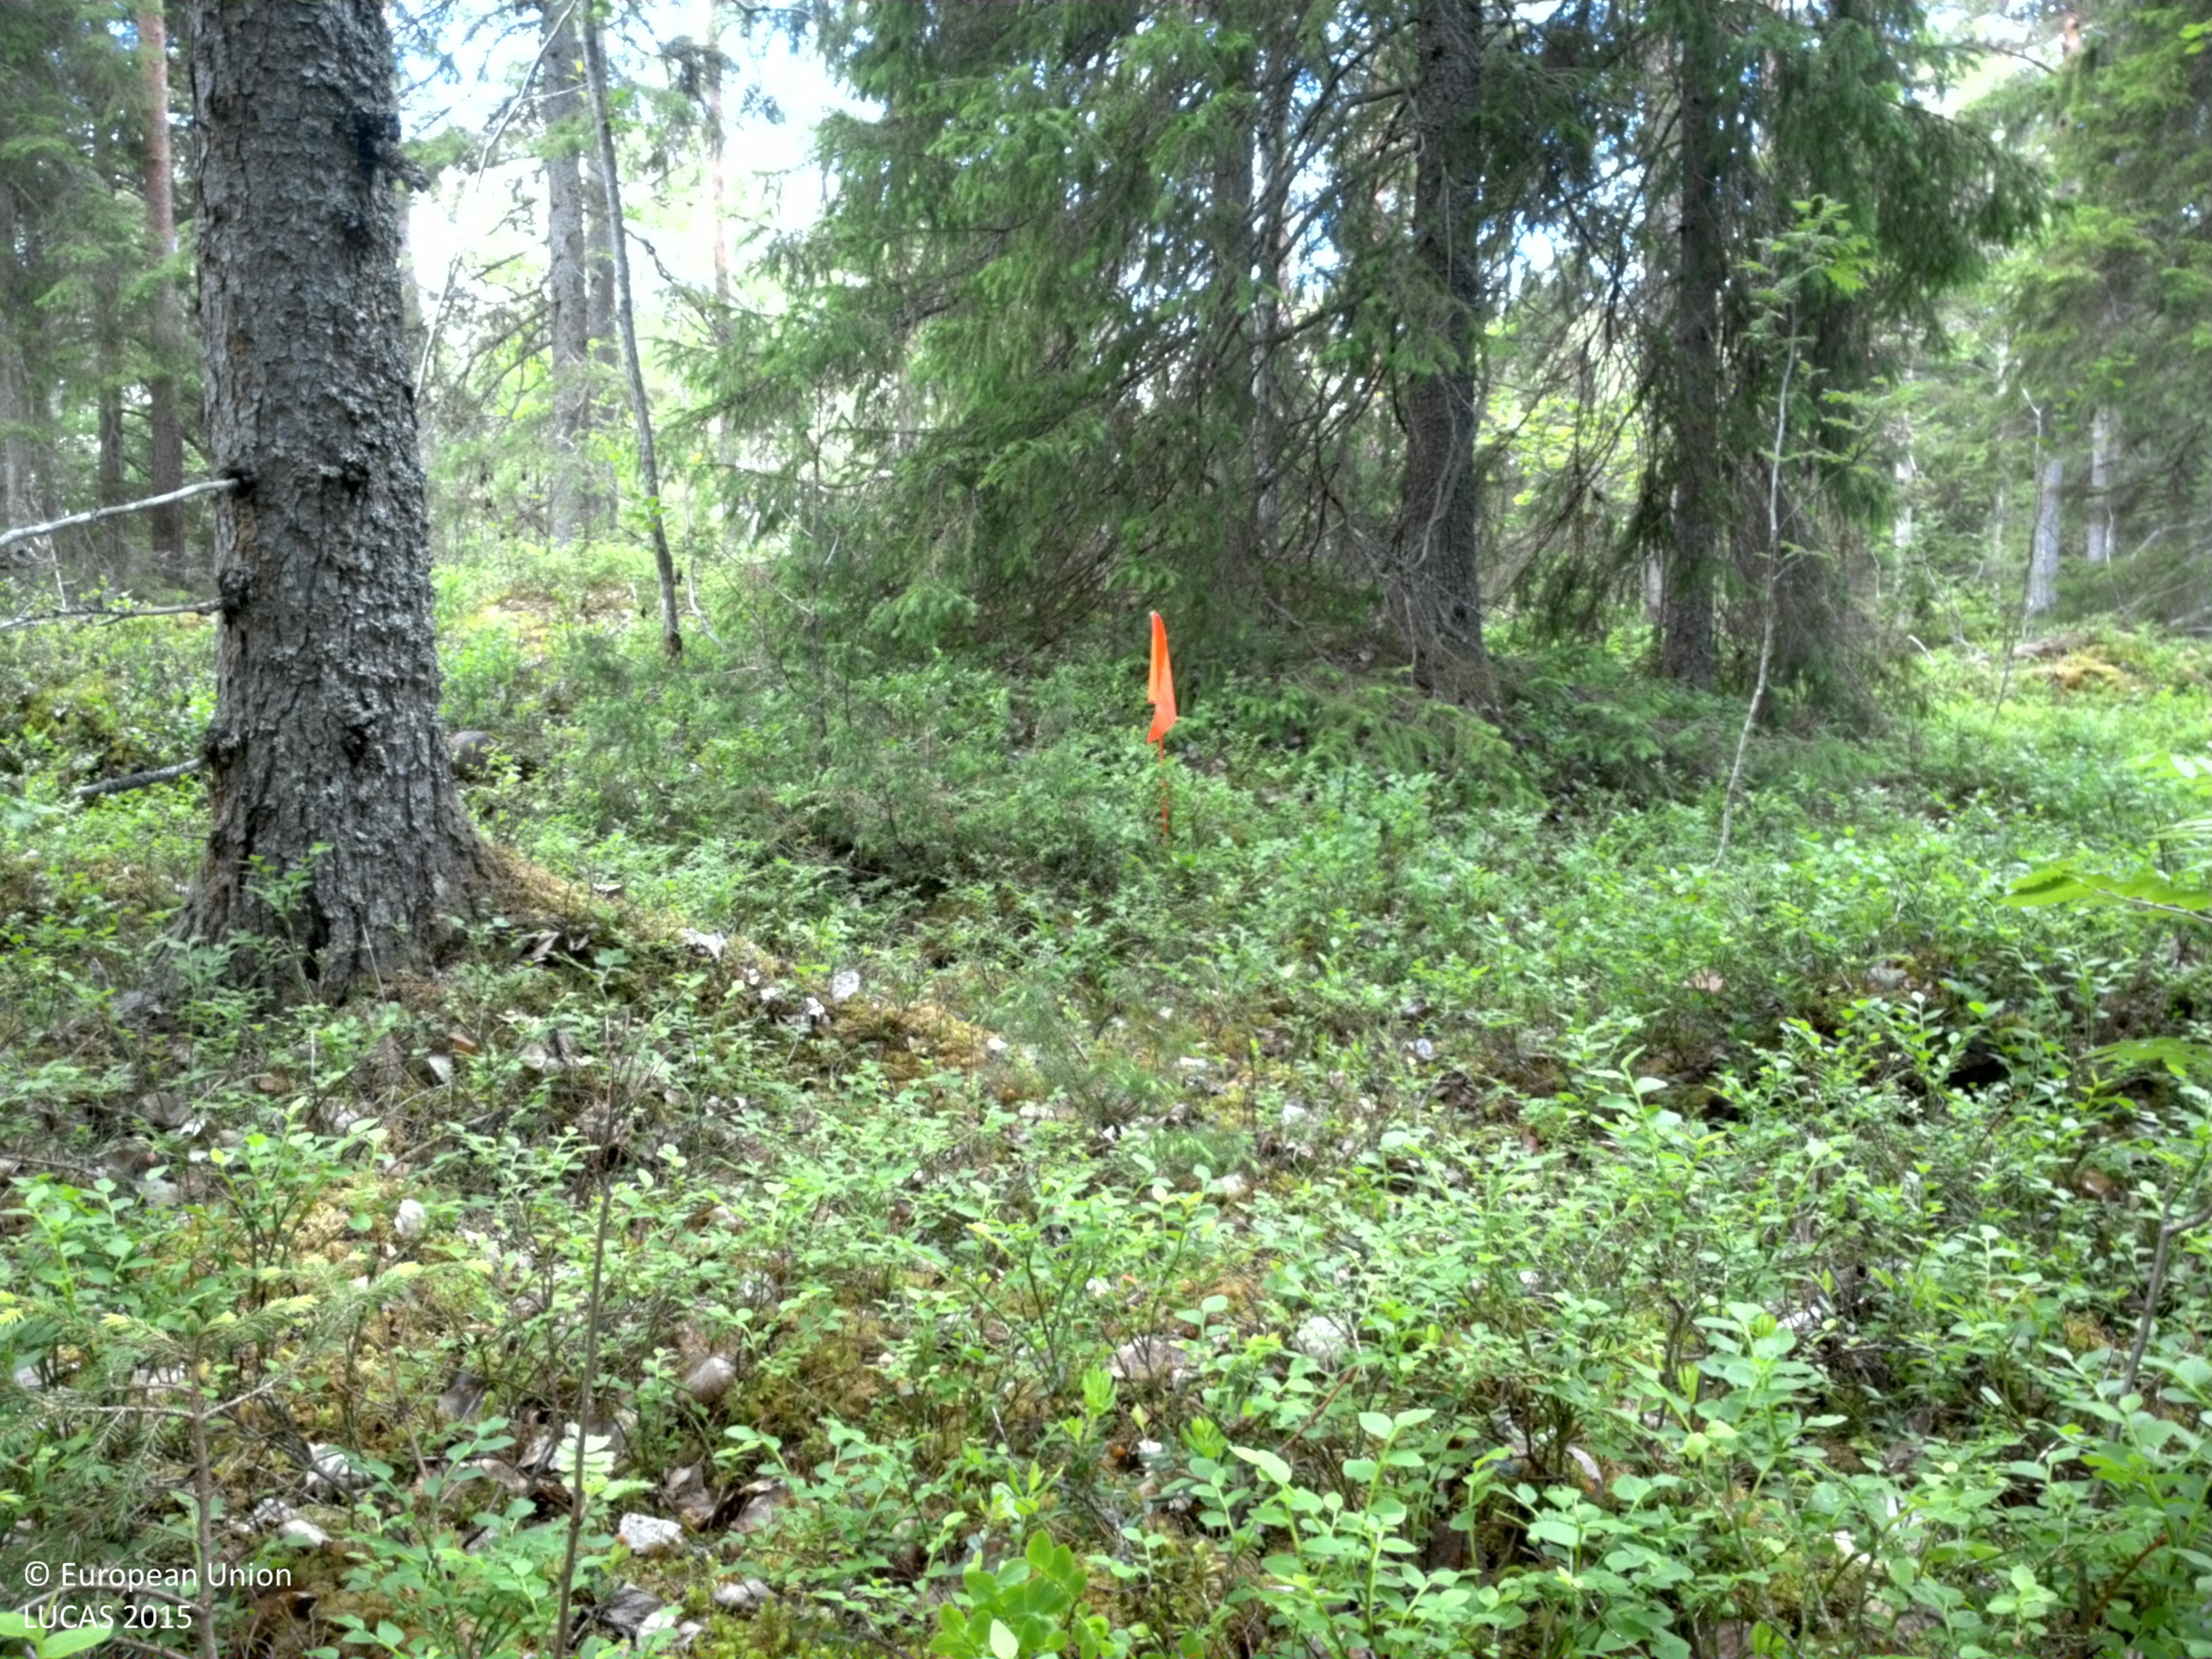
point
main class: Woodland
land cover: Spruce dominated coniferous woodland
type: boreal forest
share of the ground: 50 - 75 %
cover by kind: coniferous forest trees 55 %, herbaceous plants 20 %, lichens and mosses 20 %, broadleaved forest trees 5 %
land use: Forestry
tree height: > 5 m
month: June
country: SE
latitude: 60.0939
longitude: 18.6831
